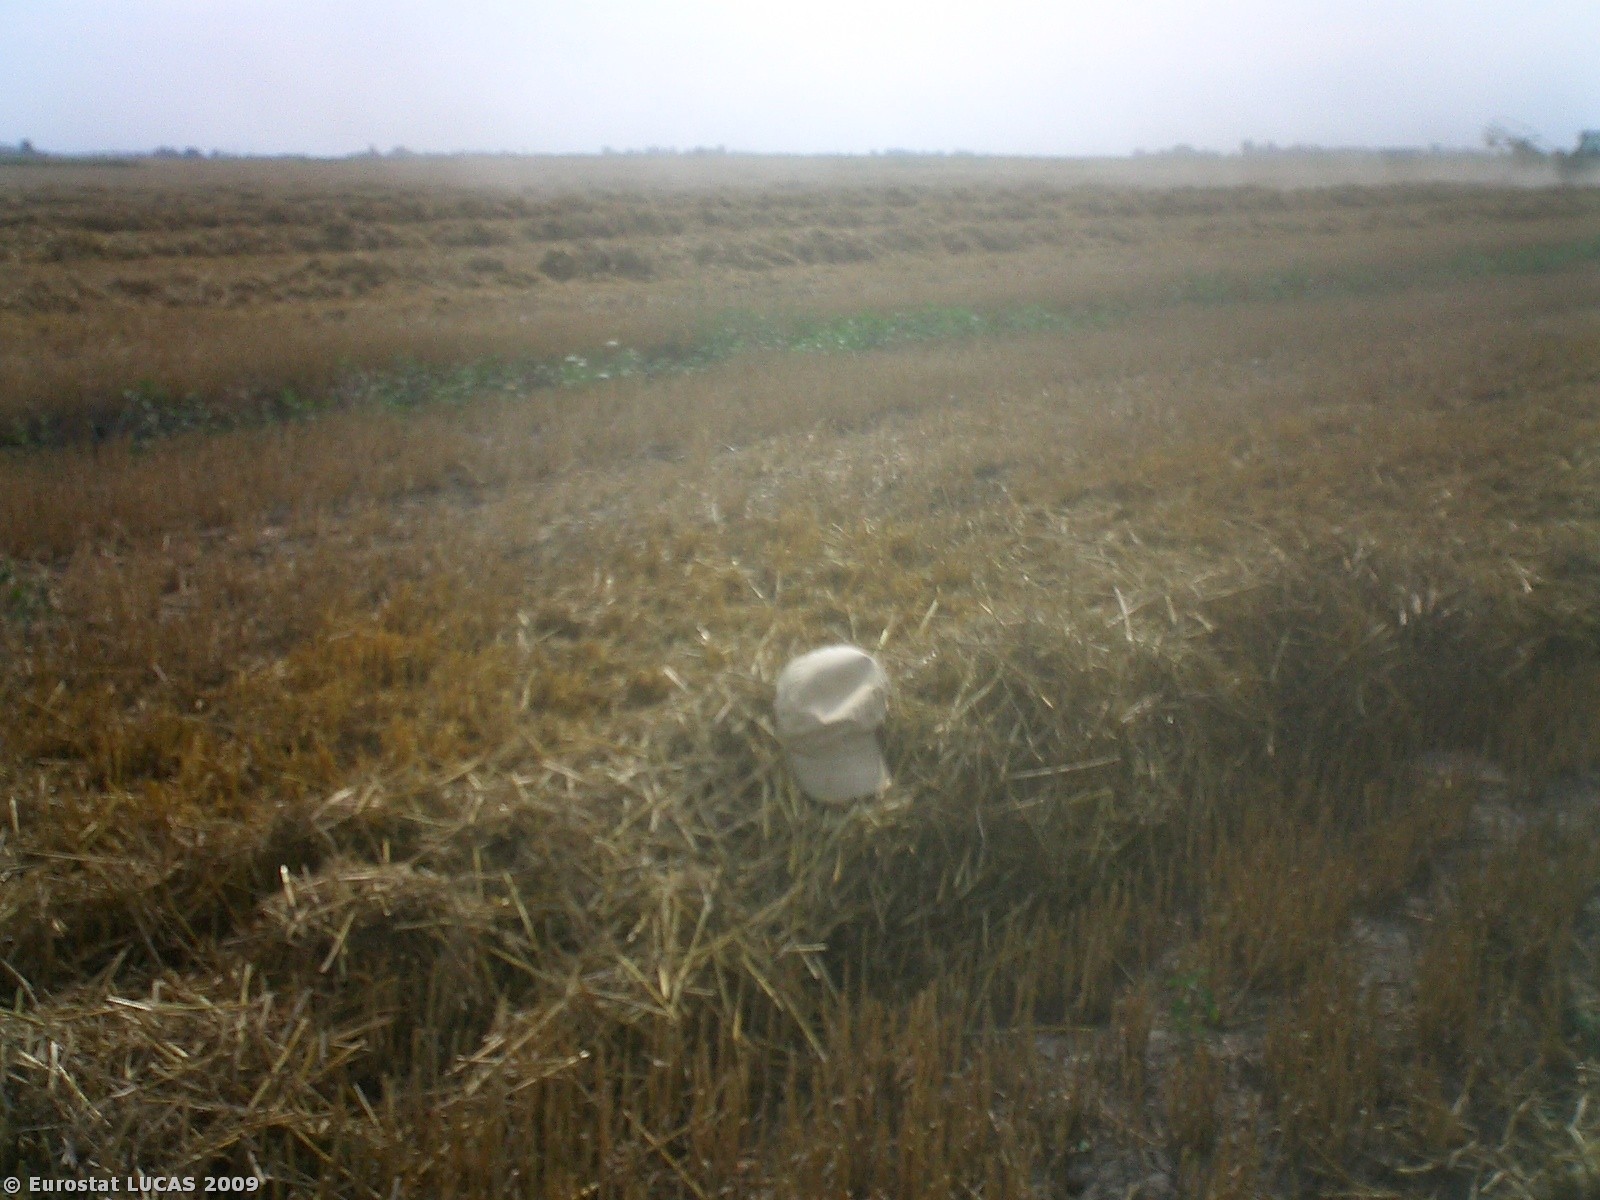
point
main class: Cropland
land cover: Common wheat
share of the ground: > 75 %
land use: Agriculture (excluding fallow land and kitchen gardens)
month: July
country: IT
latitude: 44.6204
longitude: 11.9746
